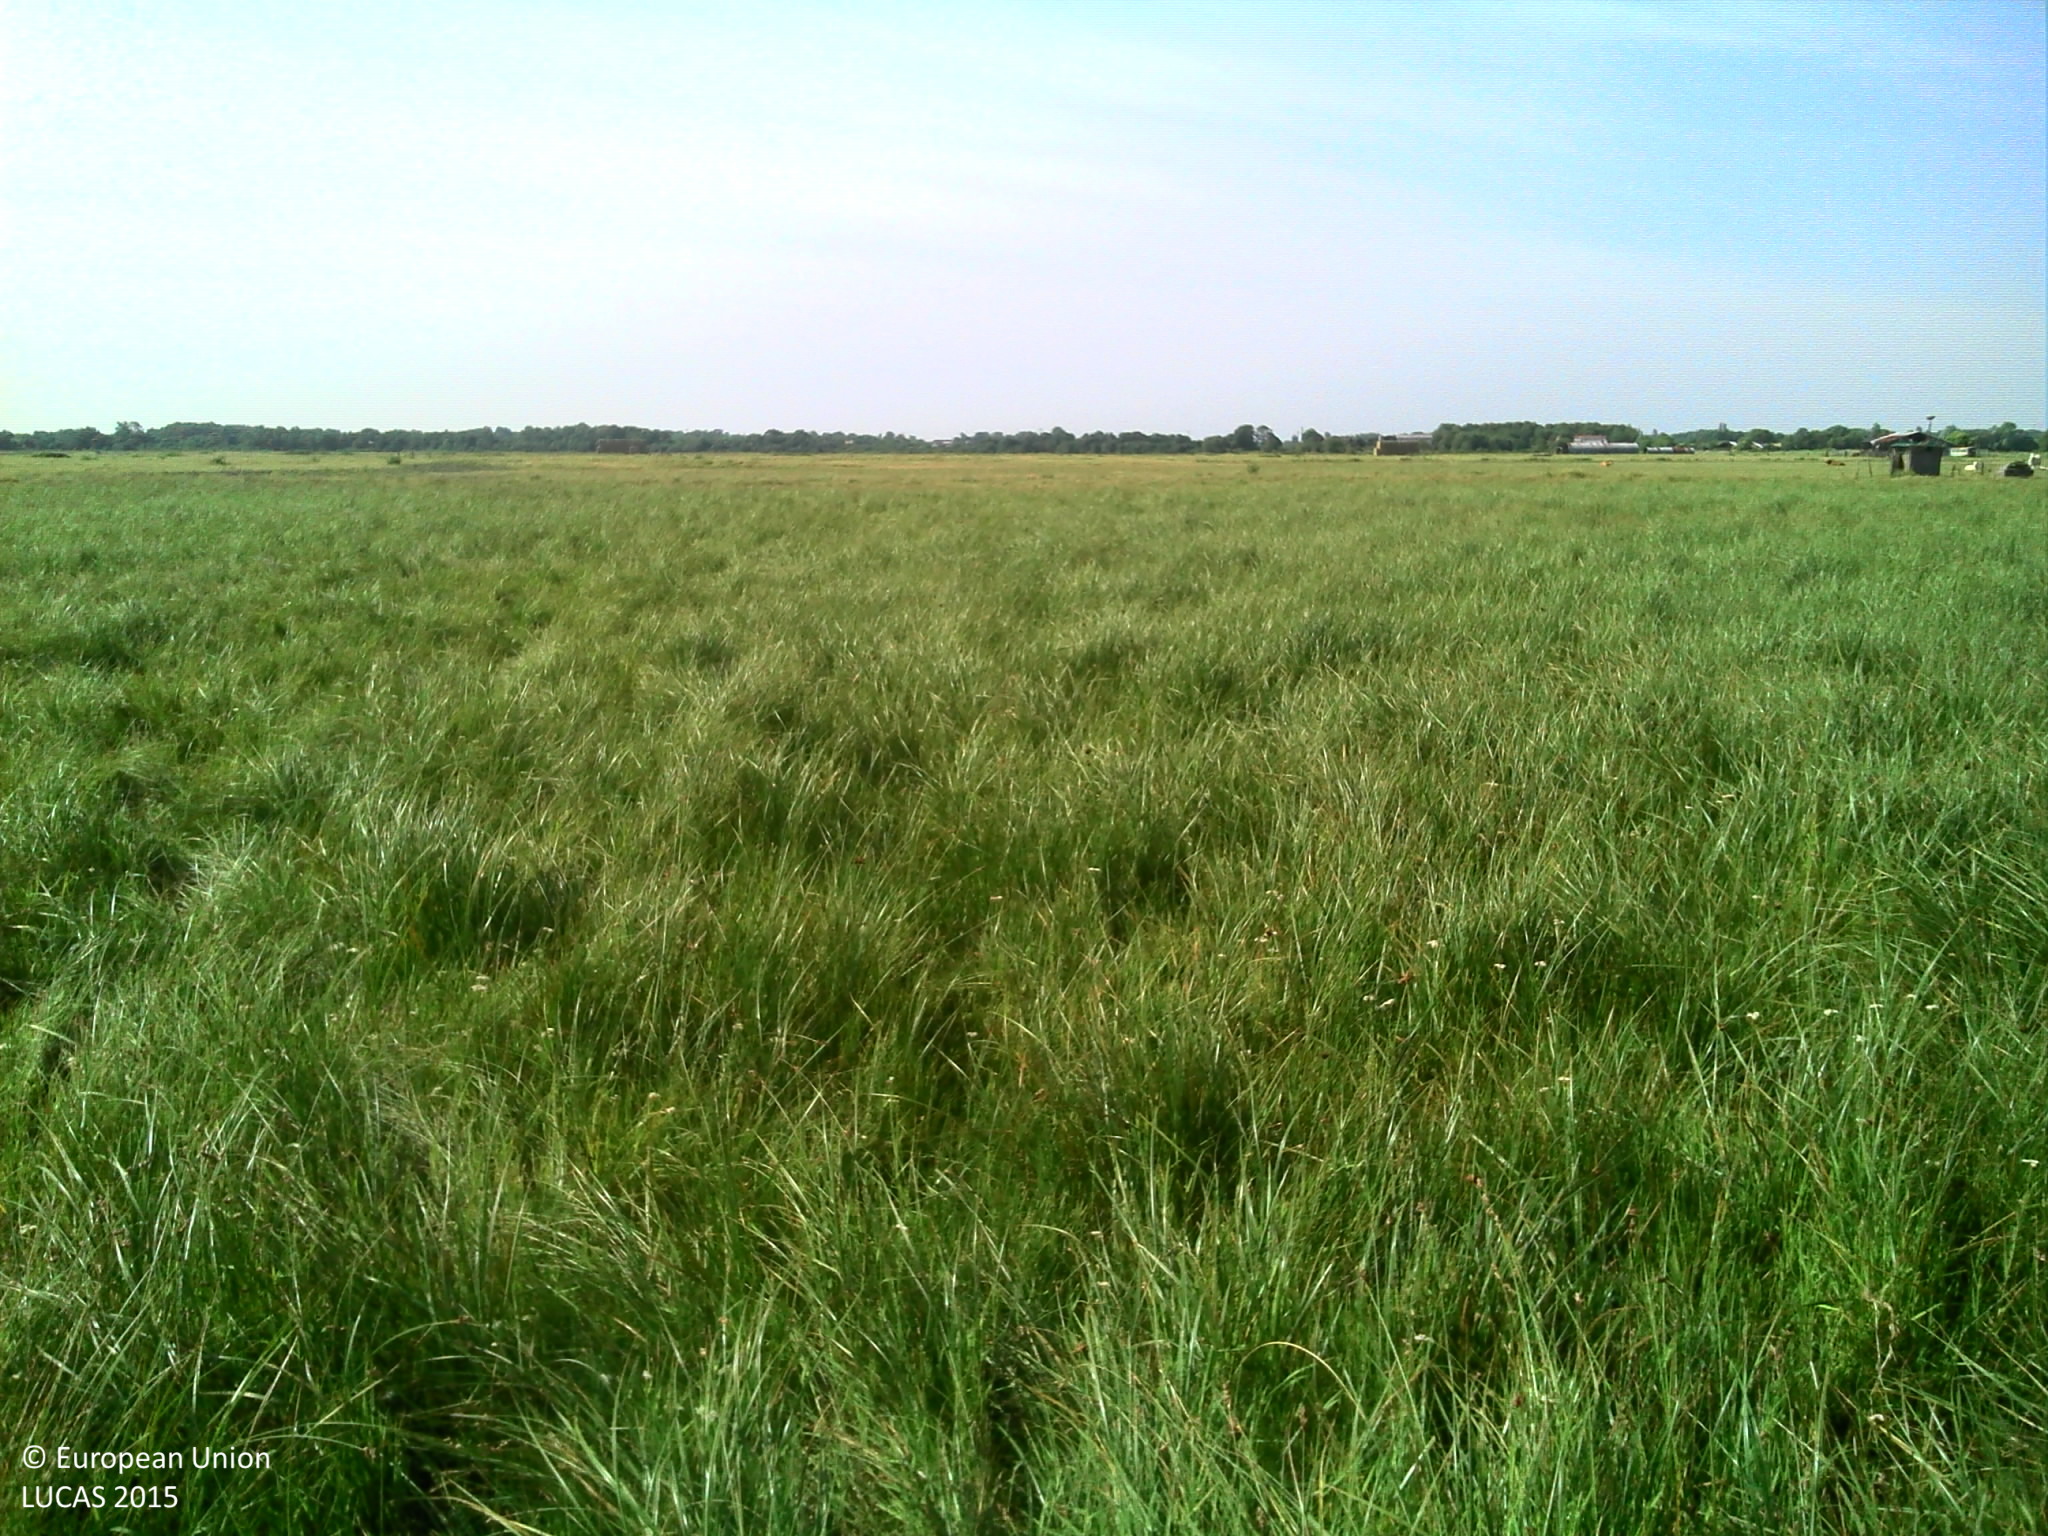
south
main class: Grassland
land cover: Grassland without tree/shrub cover
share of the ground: > 75 %
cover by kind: herbaceous plants 95 %, shrubs 5 %
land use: Agriculture (excluding fallow land and kitchen gardens)
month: June
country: FR
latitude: 46.0161
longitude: -1.0213
